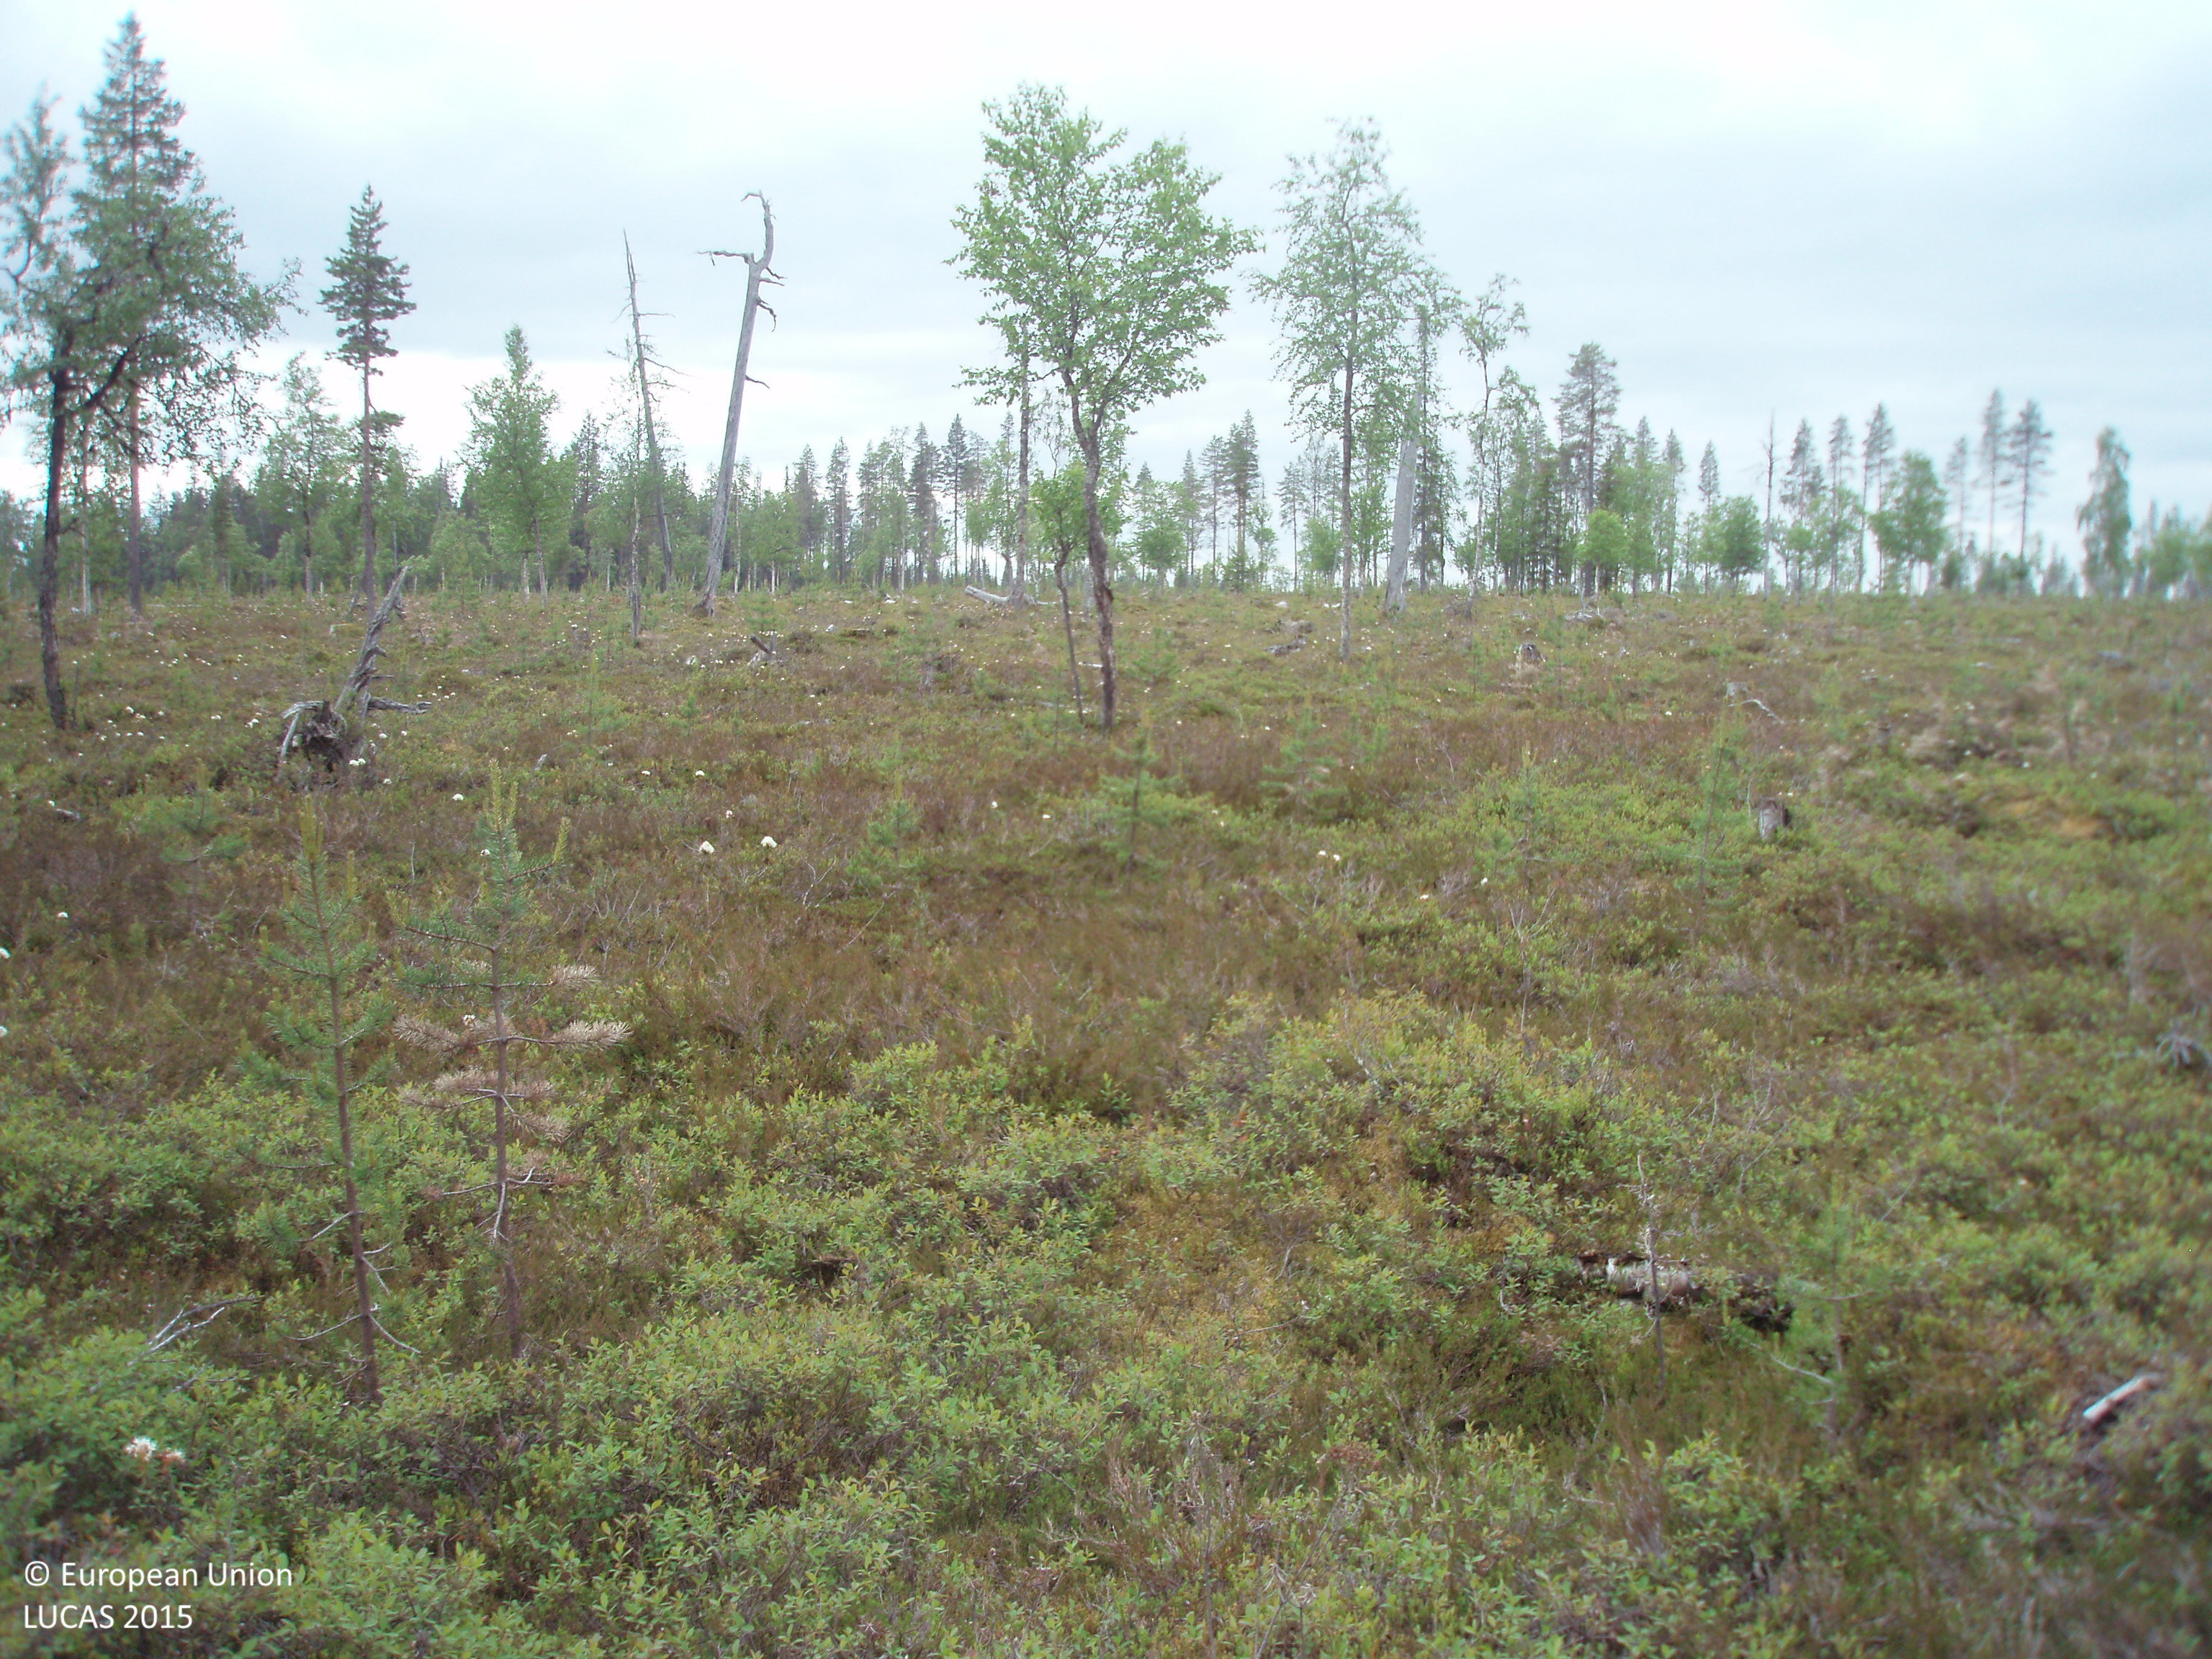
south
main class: Woodland
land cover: Pine dominated mixed woodland
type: boreal forest
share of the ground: 25 - 50 %
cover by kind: shrubs 60 %, coniferous forest trees 20 %, broadleaved forest trees 20 %
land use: Forestry
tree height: > 5 m
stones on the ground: 10 - 25 %
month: July
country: FI
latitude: 67.6828
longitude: 28.6060
